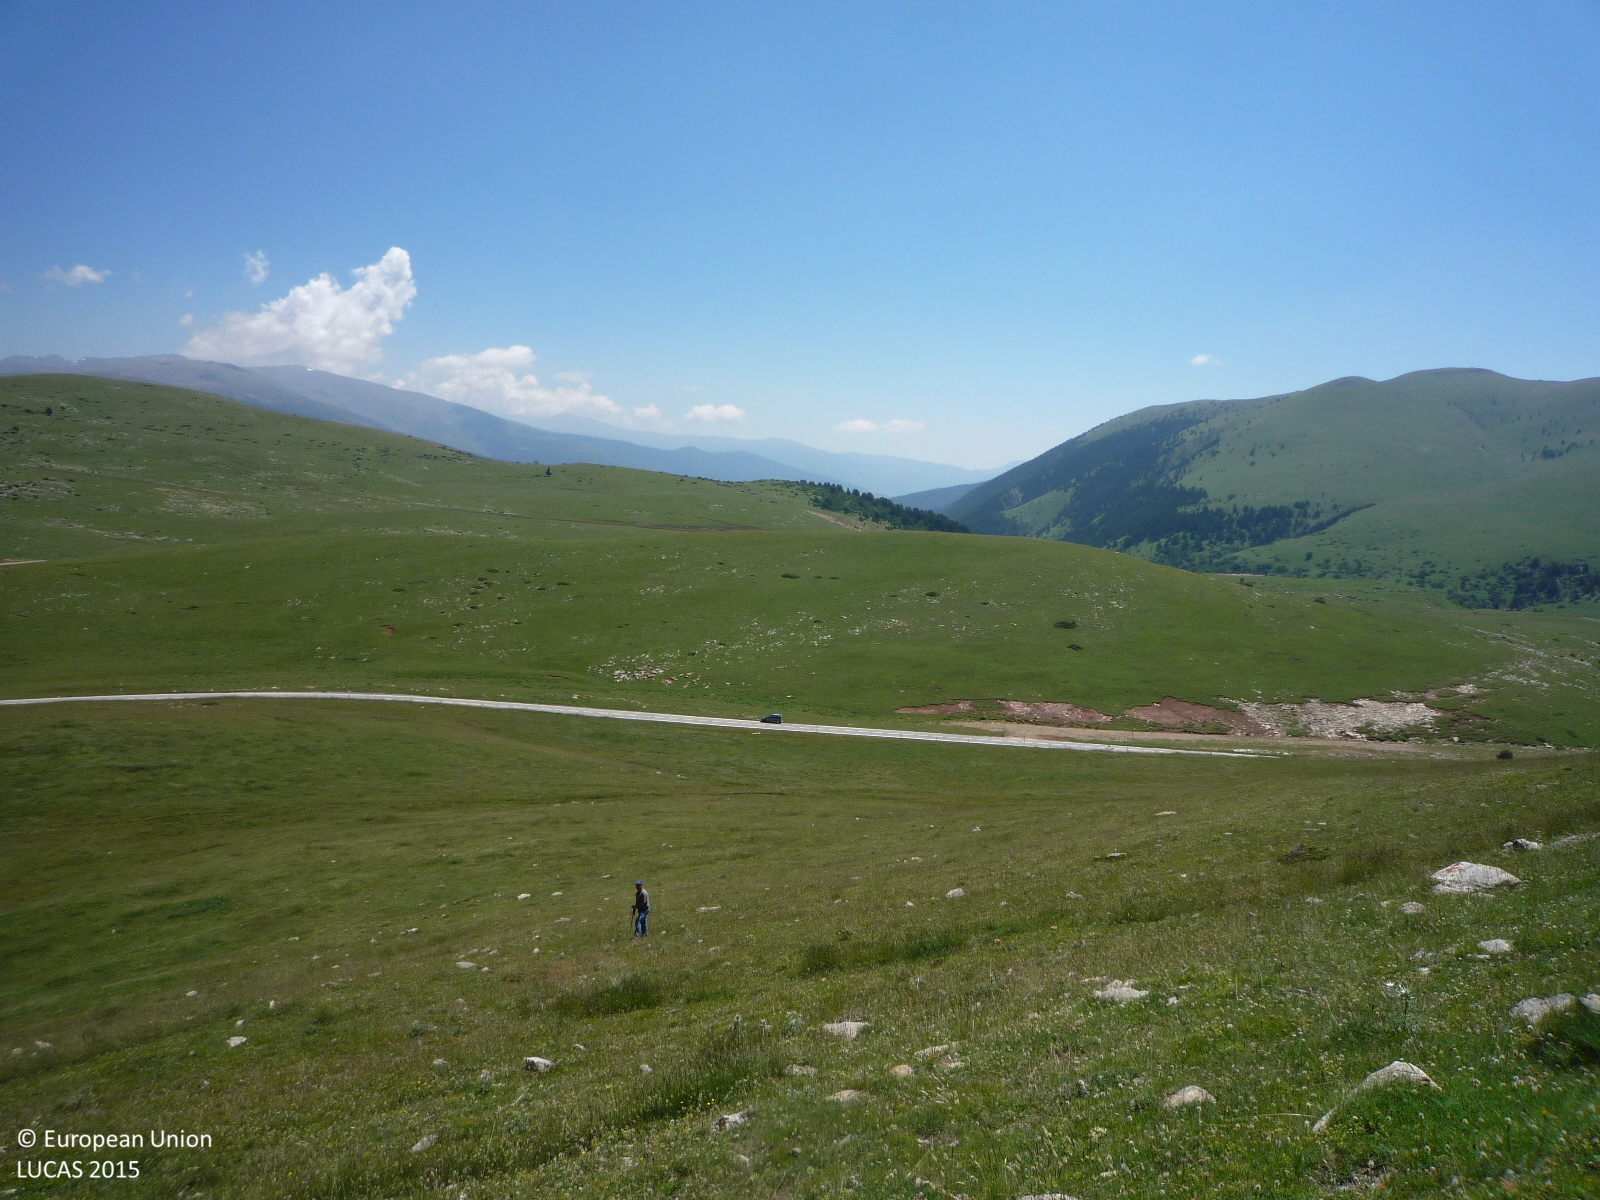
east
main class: Grassland
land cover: Grassland without tree/shrub cover
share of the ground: > 75 %
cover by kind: herbaceous plants 100 %
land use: Sport
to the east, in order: Grassland without tree/shrub cover; Fences; Grass margins; Paved roads, cycling and walking lanes; Fences; Grassland without tree/shrub cover
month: June
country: ES
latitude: 42.3165
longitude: 1.9677
